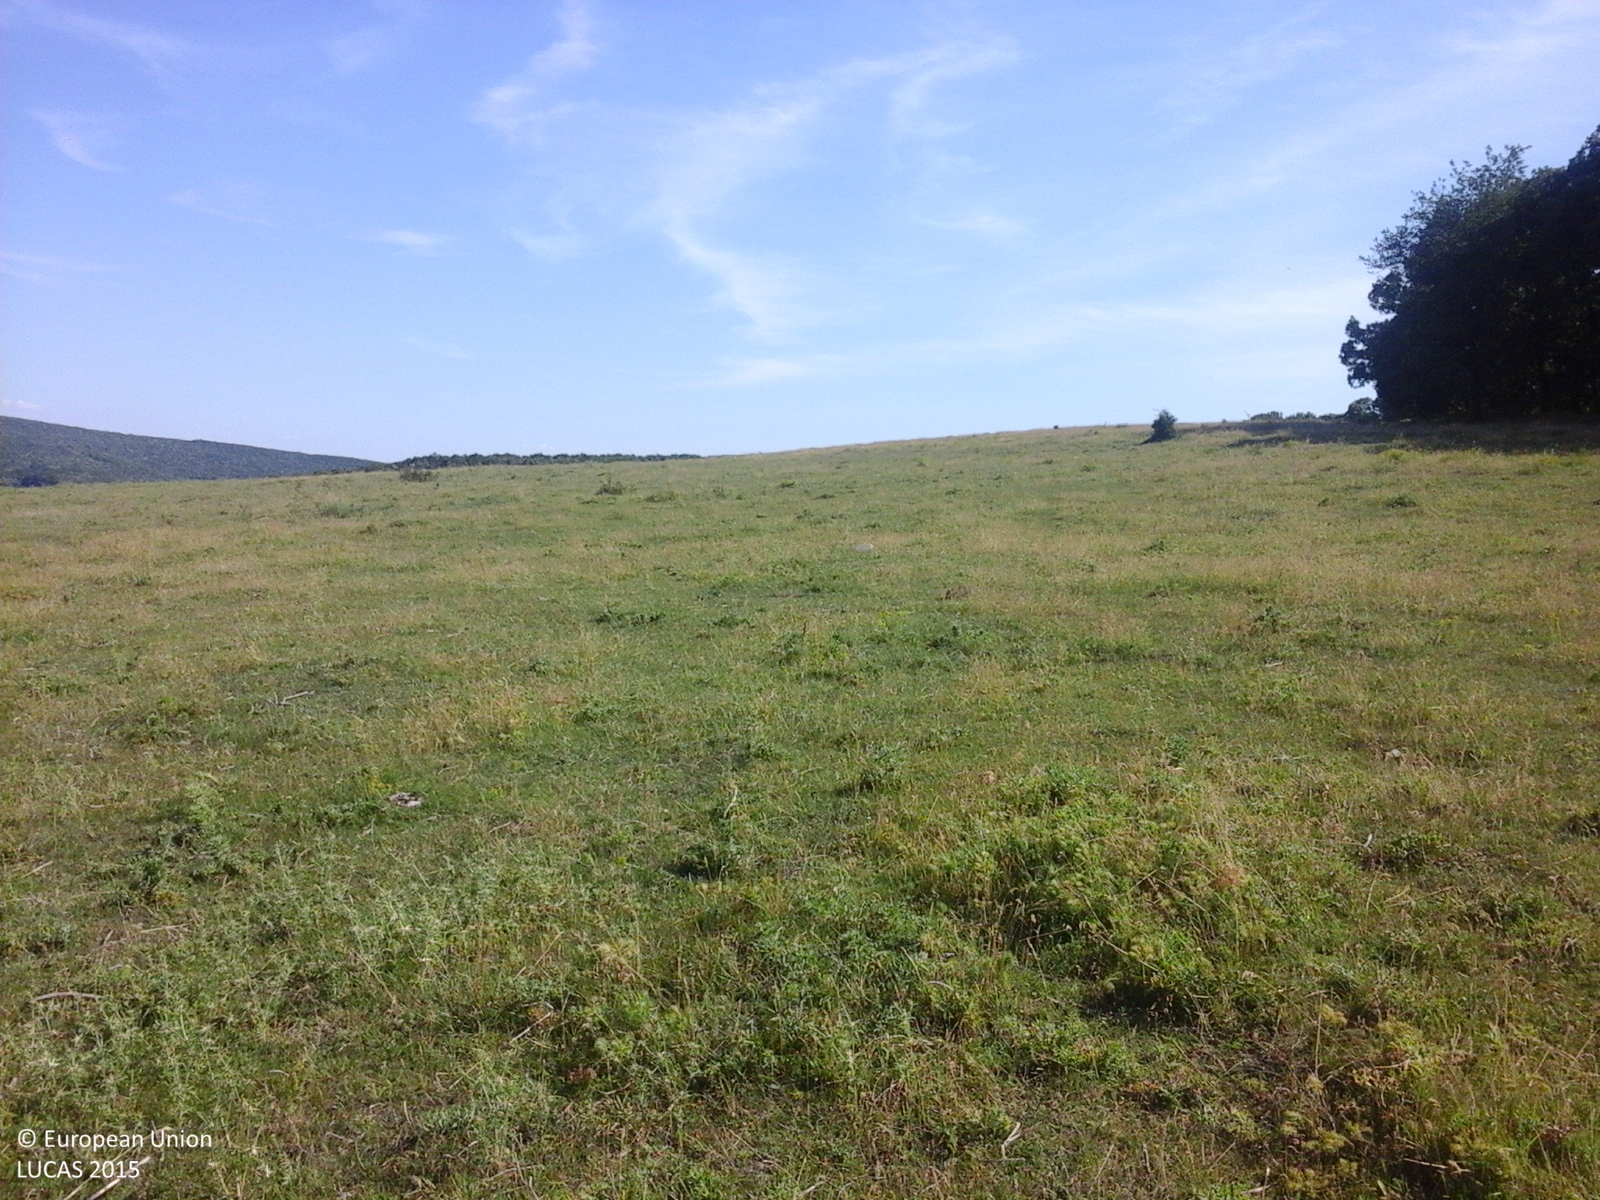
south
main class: Grassland
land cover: Grassland without tree/shrub cover
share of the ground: > 75 %
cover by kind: herbaceous plants 100 %
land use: Agriculture (excluding fallow land and kitchen gardens)
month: June
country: RO
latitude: 47.1187
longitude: 27.0654
